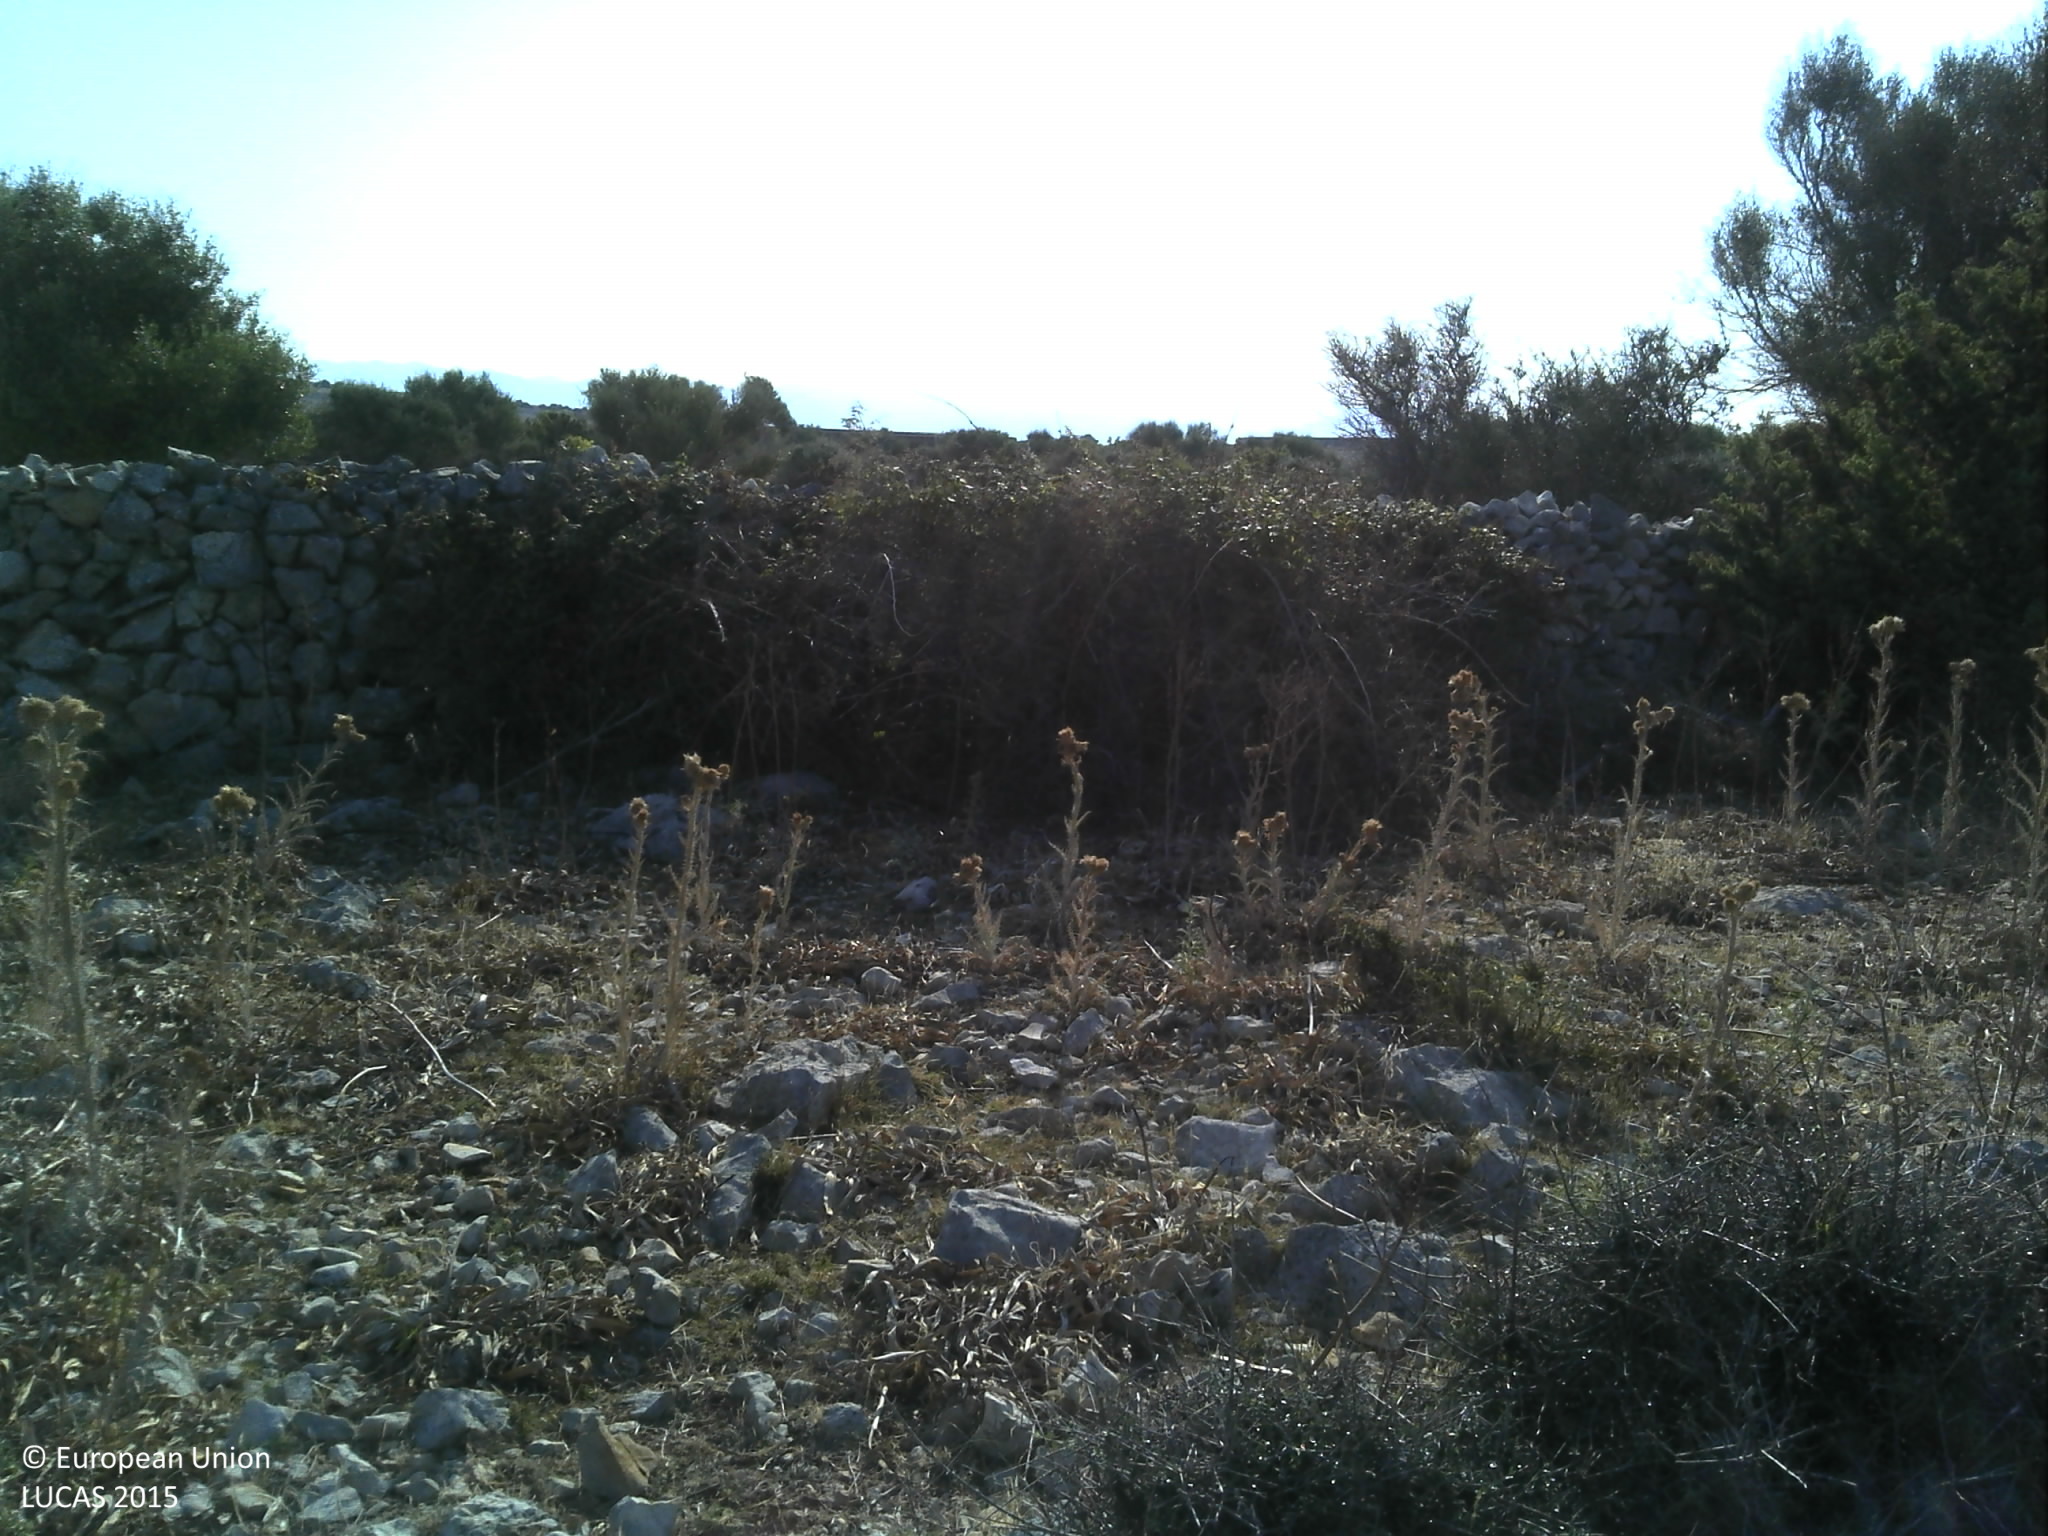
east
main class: Grassland
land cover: Grassland with sparse tree/shrub cover
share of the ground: 25 - 50 %
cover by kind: unconsolidated bare surface 40 %, herbaceous plants 35 %, consolidated bare surface 15 %, broadleaved forest trees 5 %, shrubs 5 %
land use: Agriculture (excluding fallow land and kitchen gardens)
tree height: < 5 m
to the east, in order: Grassland with sparse tree/shrub cover; Dry stone walls; Grassland with sparse tree/shrub cover; Tracks; Grassland with sparse tree/shrub cover
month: July
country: HR
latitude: 44.6371
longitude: 14.7964
